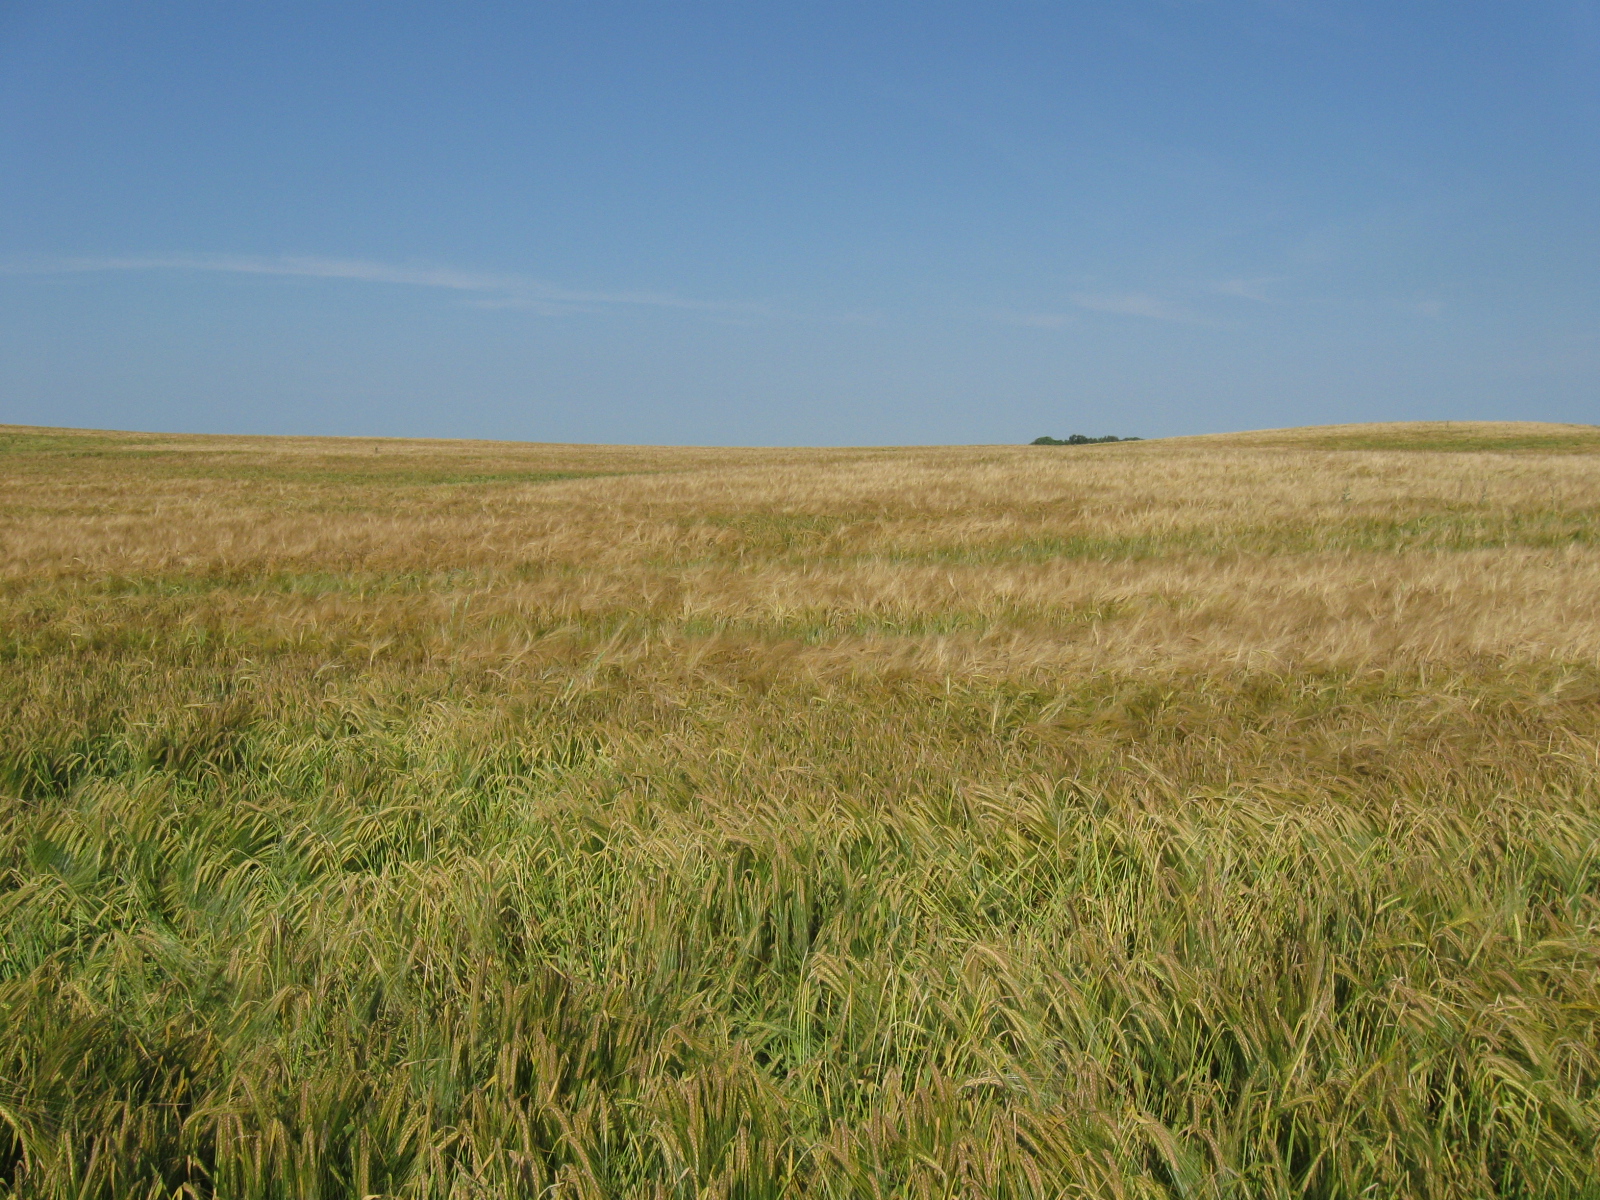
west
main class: Cropland
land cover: Barley
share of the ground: > 75 %
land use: Agriculture (excluding fallow land and kitchen gardens)
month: July
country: LT
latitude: 54.4880
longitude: 23.4650
